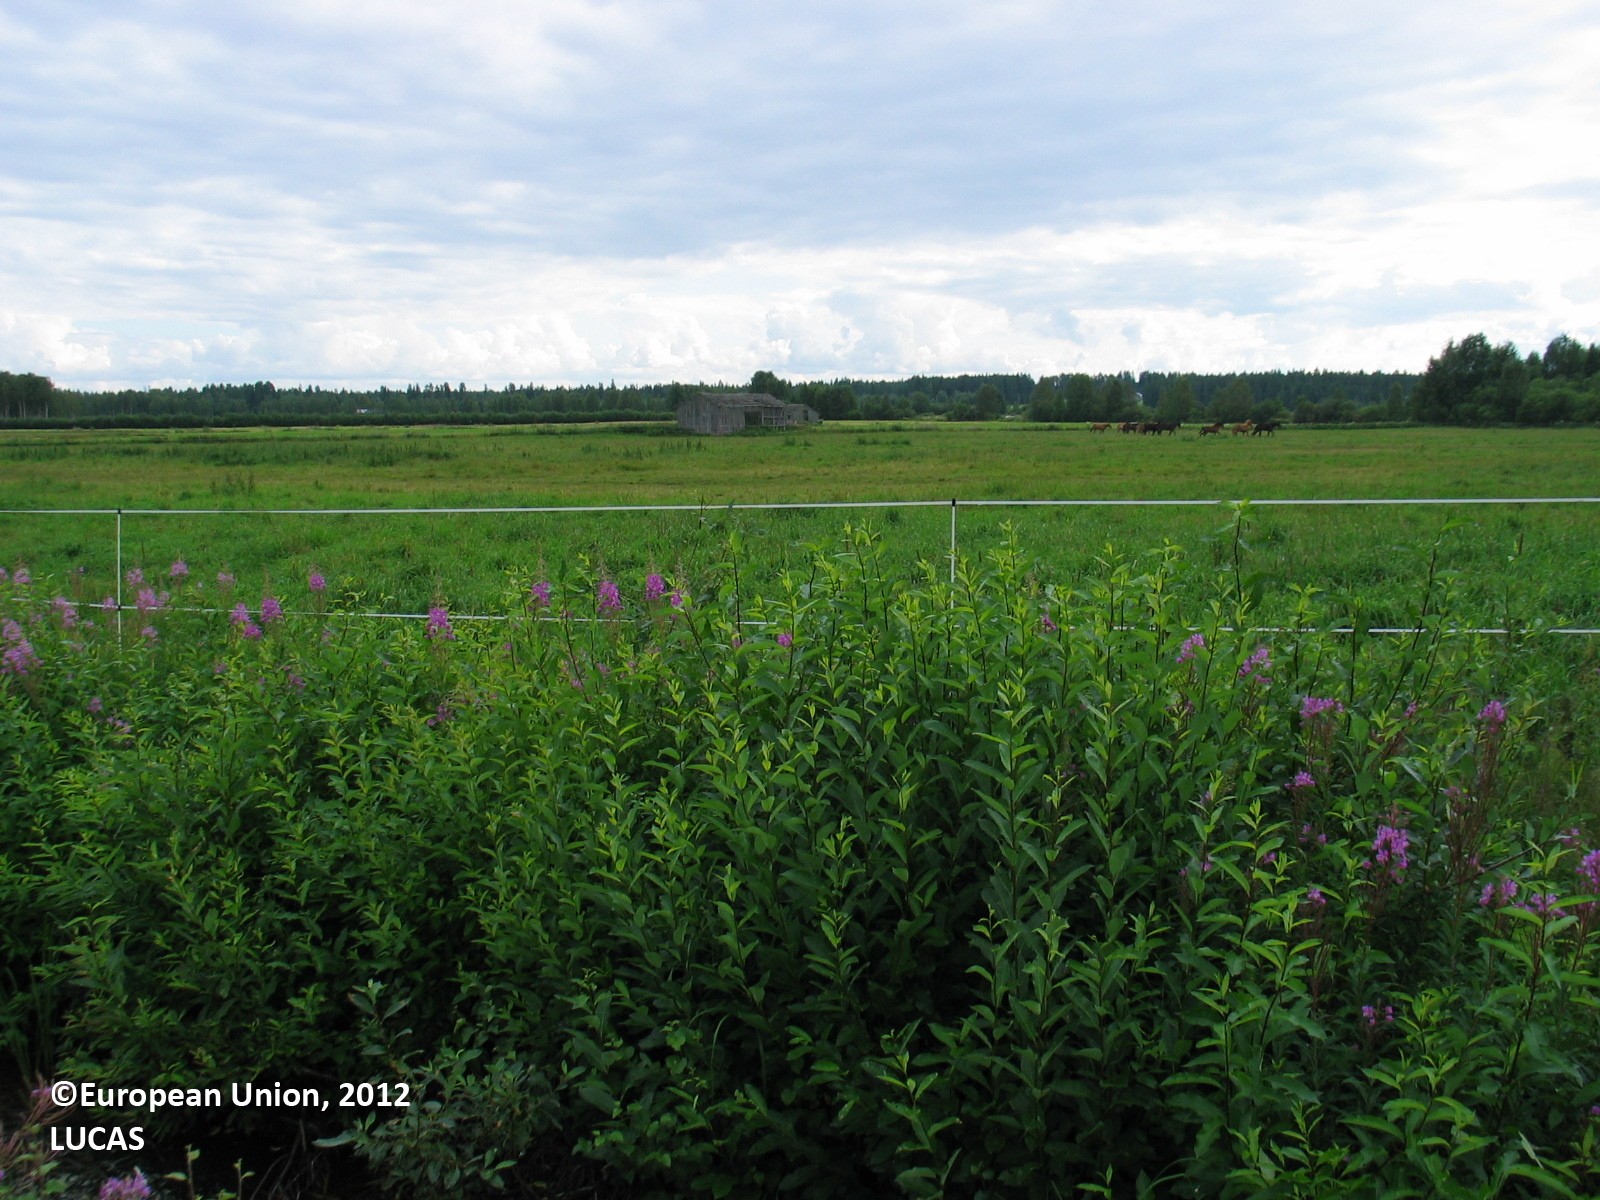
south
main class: Grassland
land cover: Grassland without tree/shrub cover
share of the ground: > 75 %
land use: Agriculture (excluding fallow land and kitchen gardens)
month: July
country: FI
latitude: 64.7676
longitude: 26.1435
